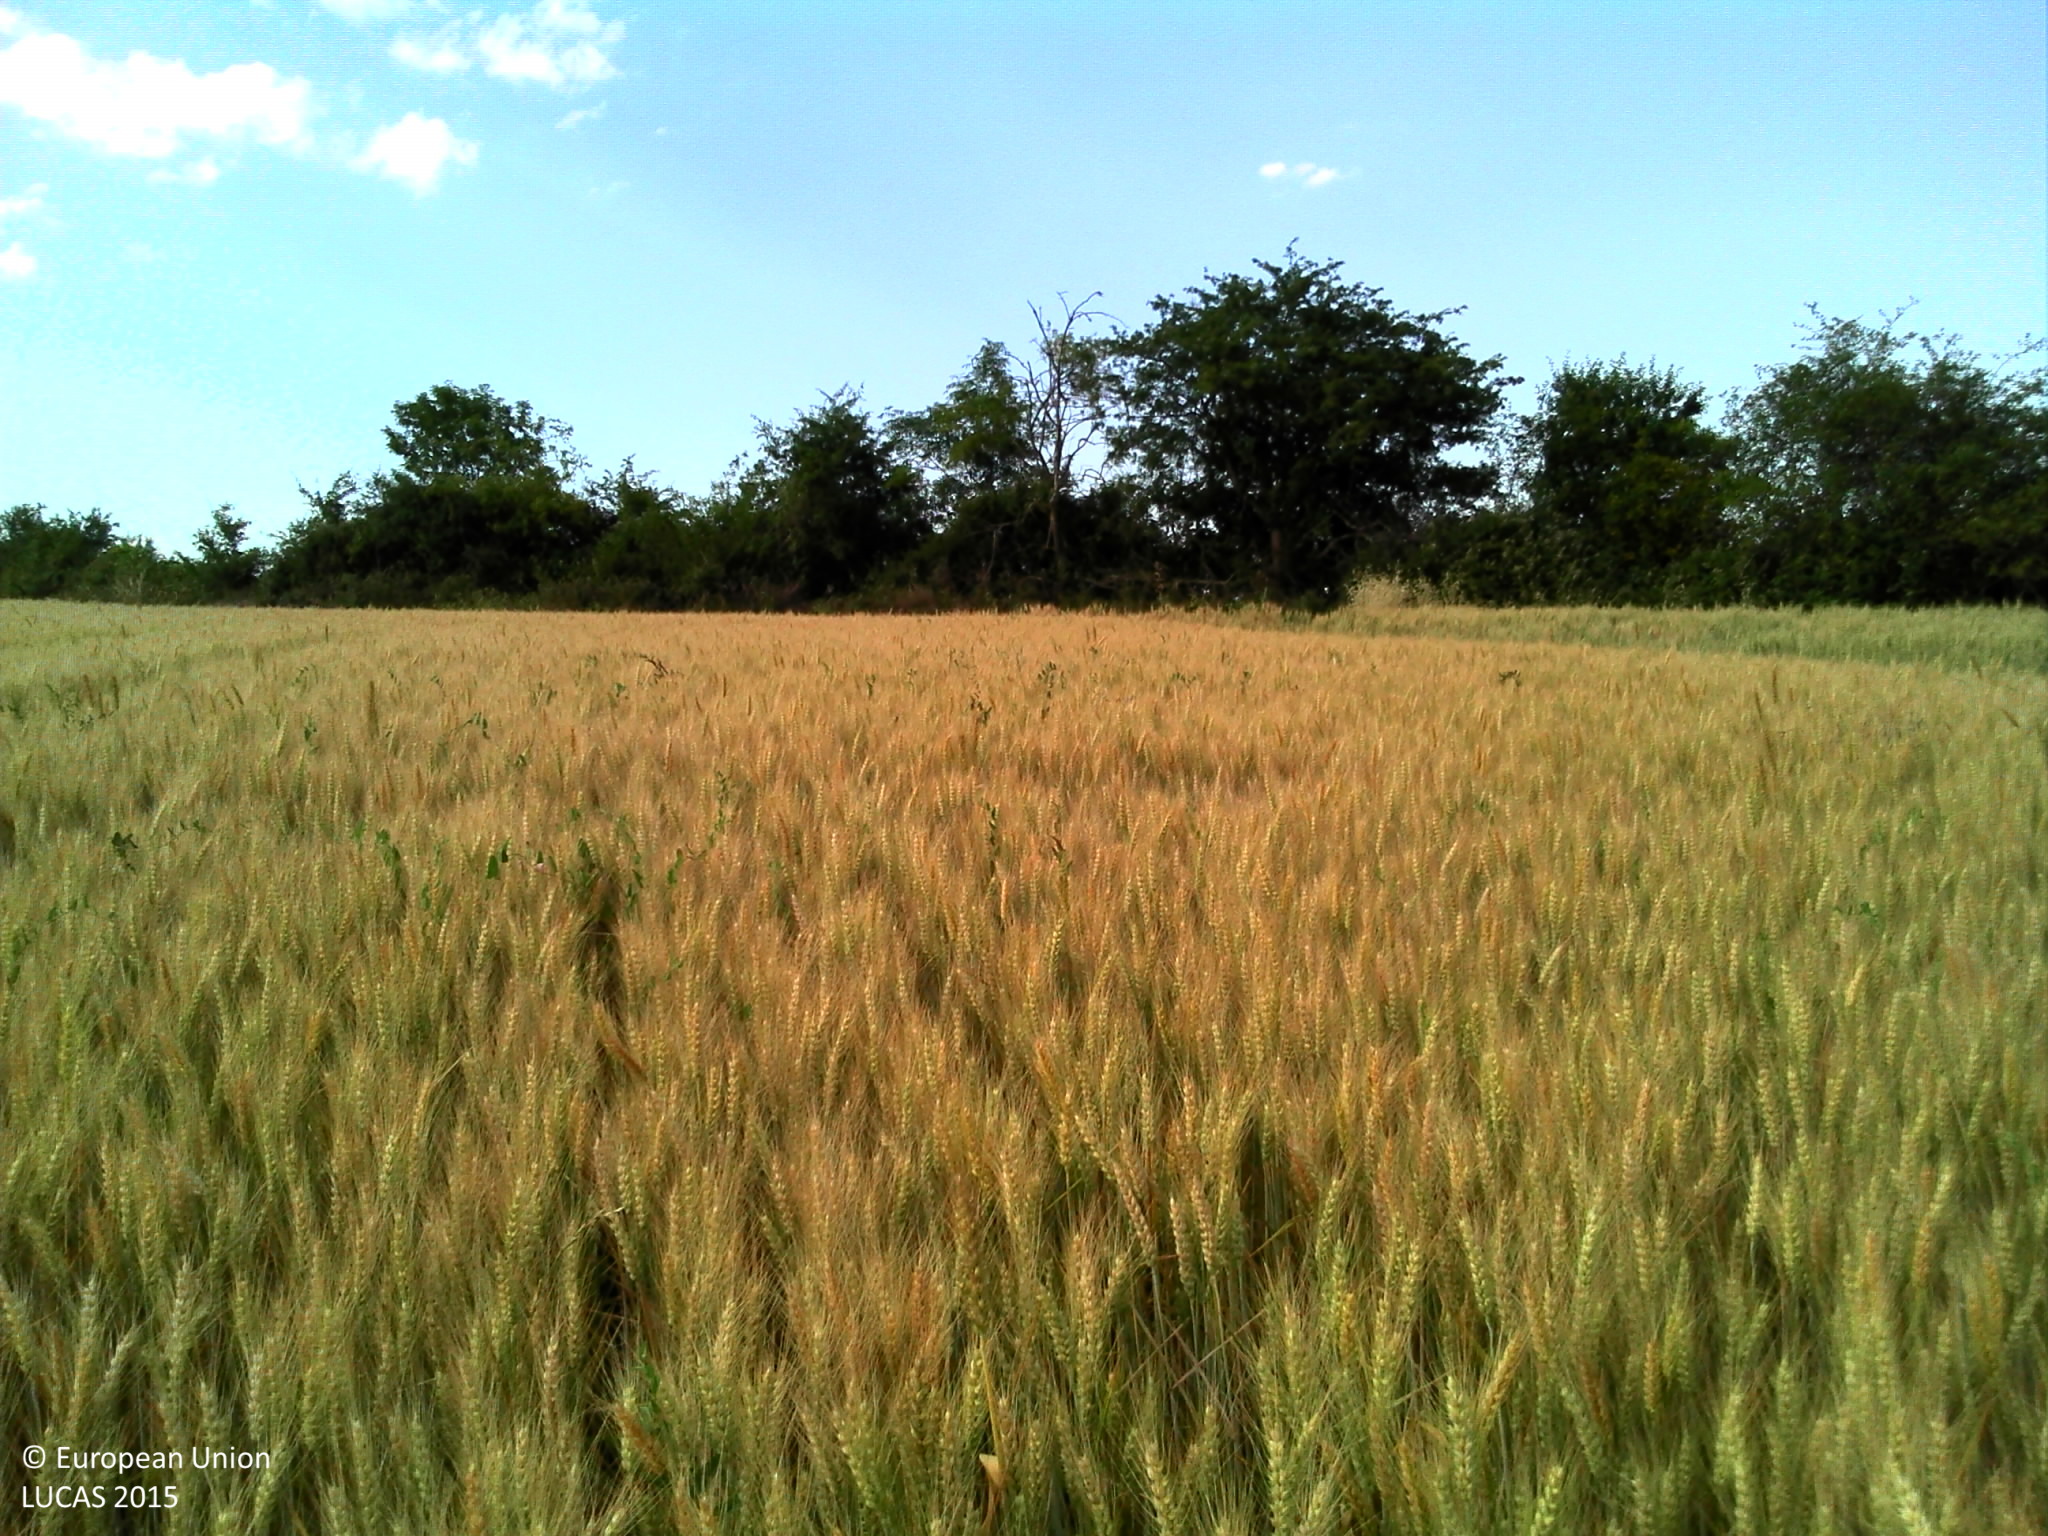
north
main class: Cropland
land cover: Common wheat
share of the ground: > 75 %
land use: Agriculture (excluding fallow land and kitchen gardens)
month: June
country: FR
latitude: 45.4974
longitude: 3.1287
